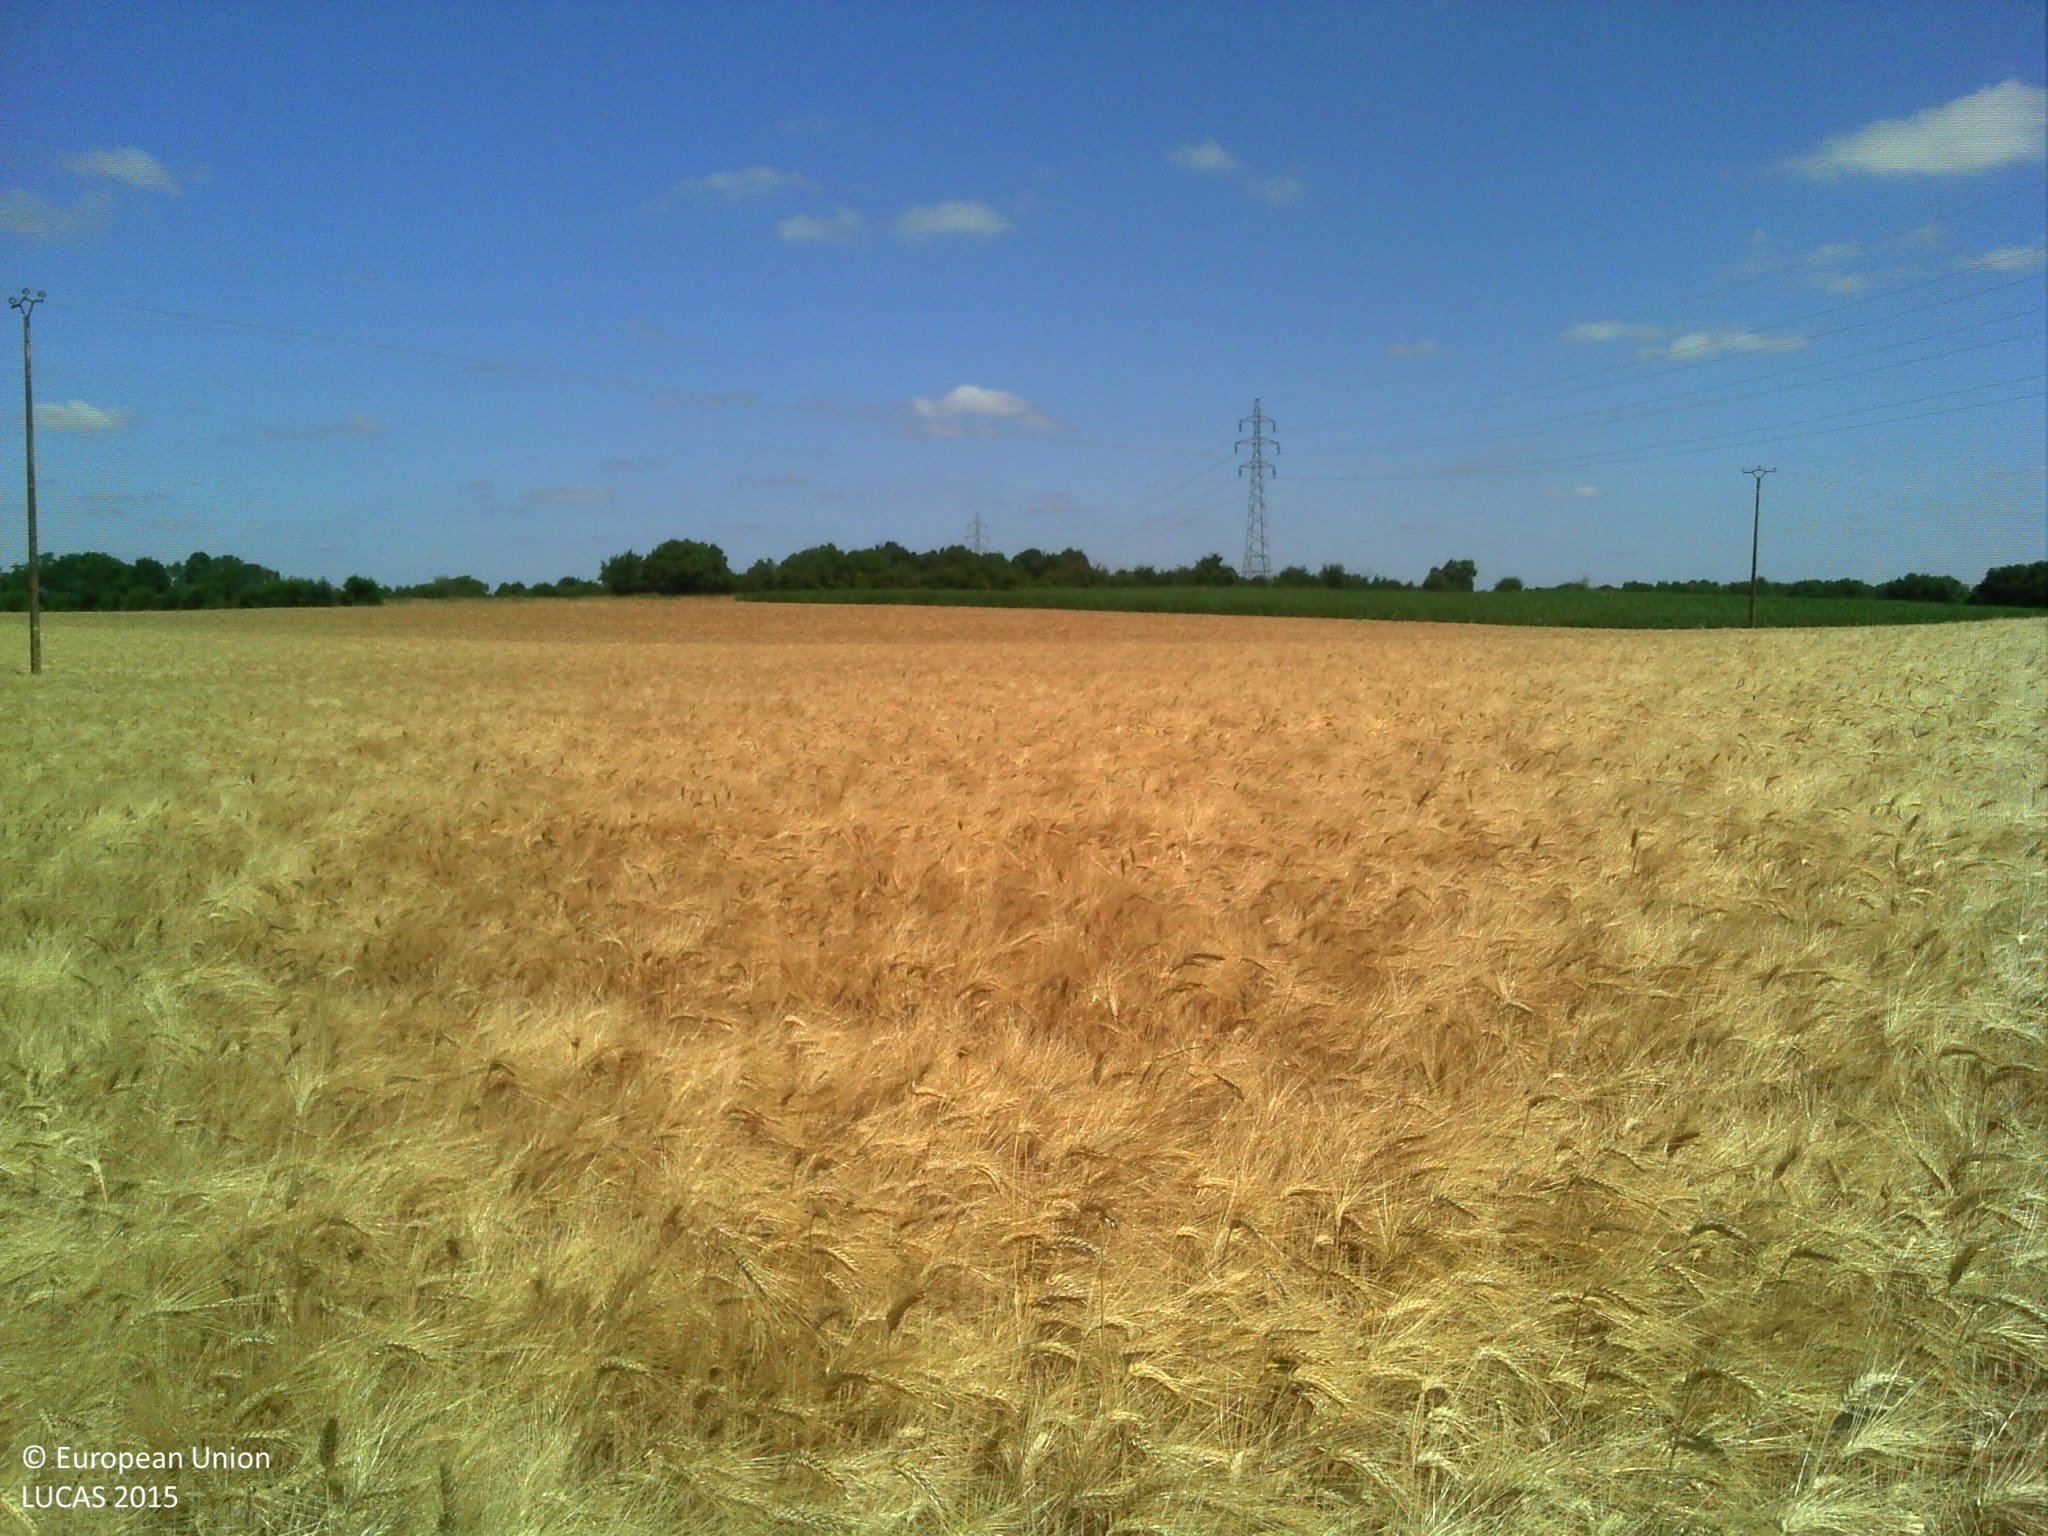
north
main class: Cropland
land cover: Common wheat
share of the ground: > 75 %
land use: Agriculture (excluding fallow land and kitchen gardens)
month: July
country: FR
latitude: 46.4390
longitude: -1.3199
